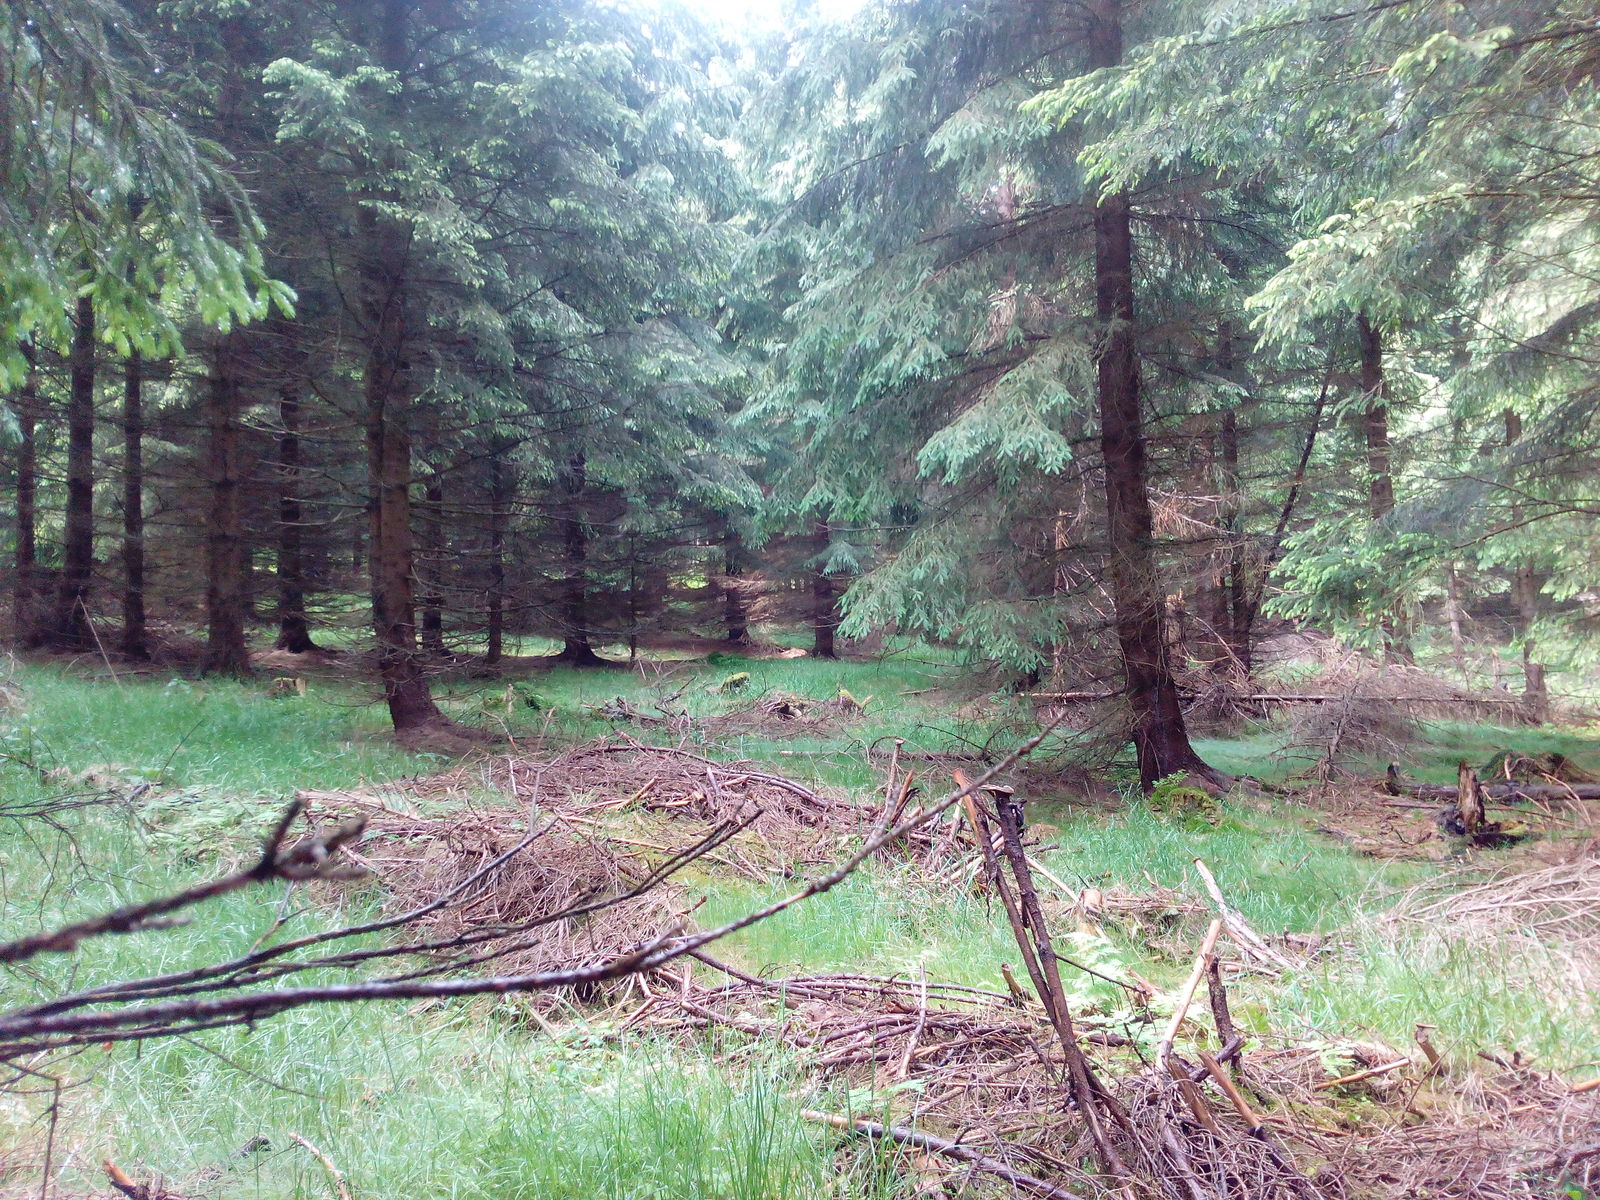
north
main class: Woodland
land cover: Spruce dominated coniferous woodland
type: hemiboreal forest and nemoral coniferous forest and mixed broadleaved-coniferous forest
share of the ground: 50 - 75 %
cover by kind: coniferous forest trees 70 %, herbaceous plants 30 %
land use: Forestry
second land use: Amenities, museums, leisure
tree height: > 5 m
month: June
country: DE
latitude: 50.5400
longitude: 10.9451
